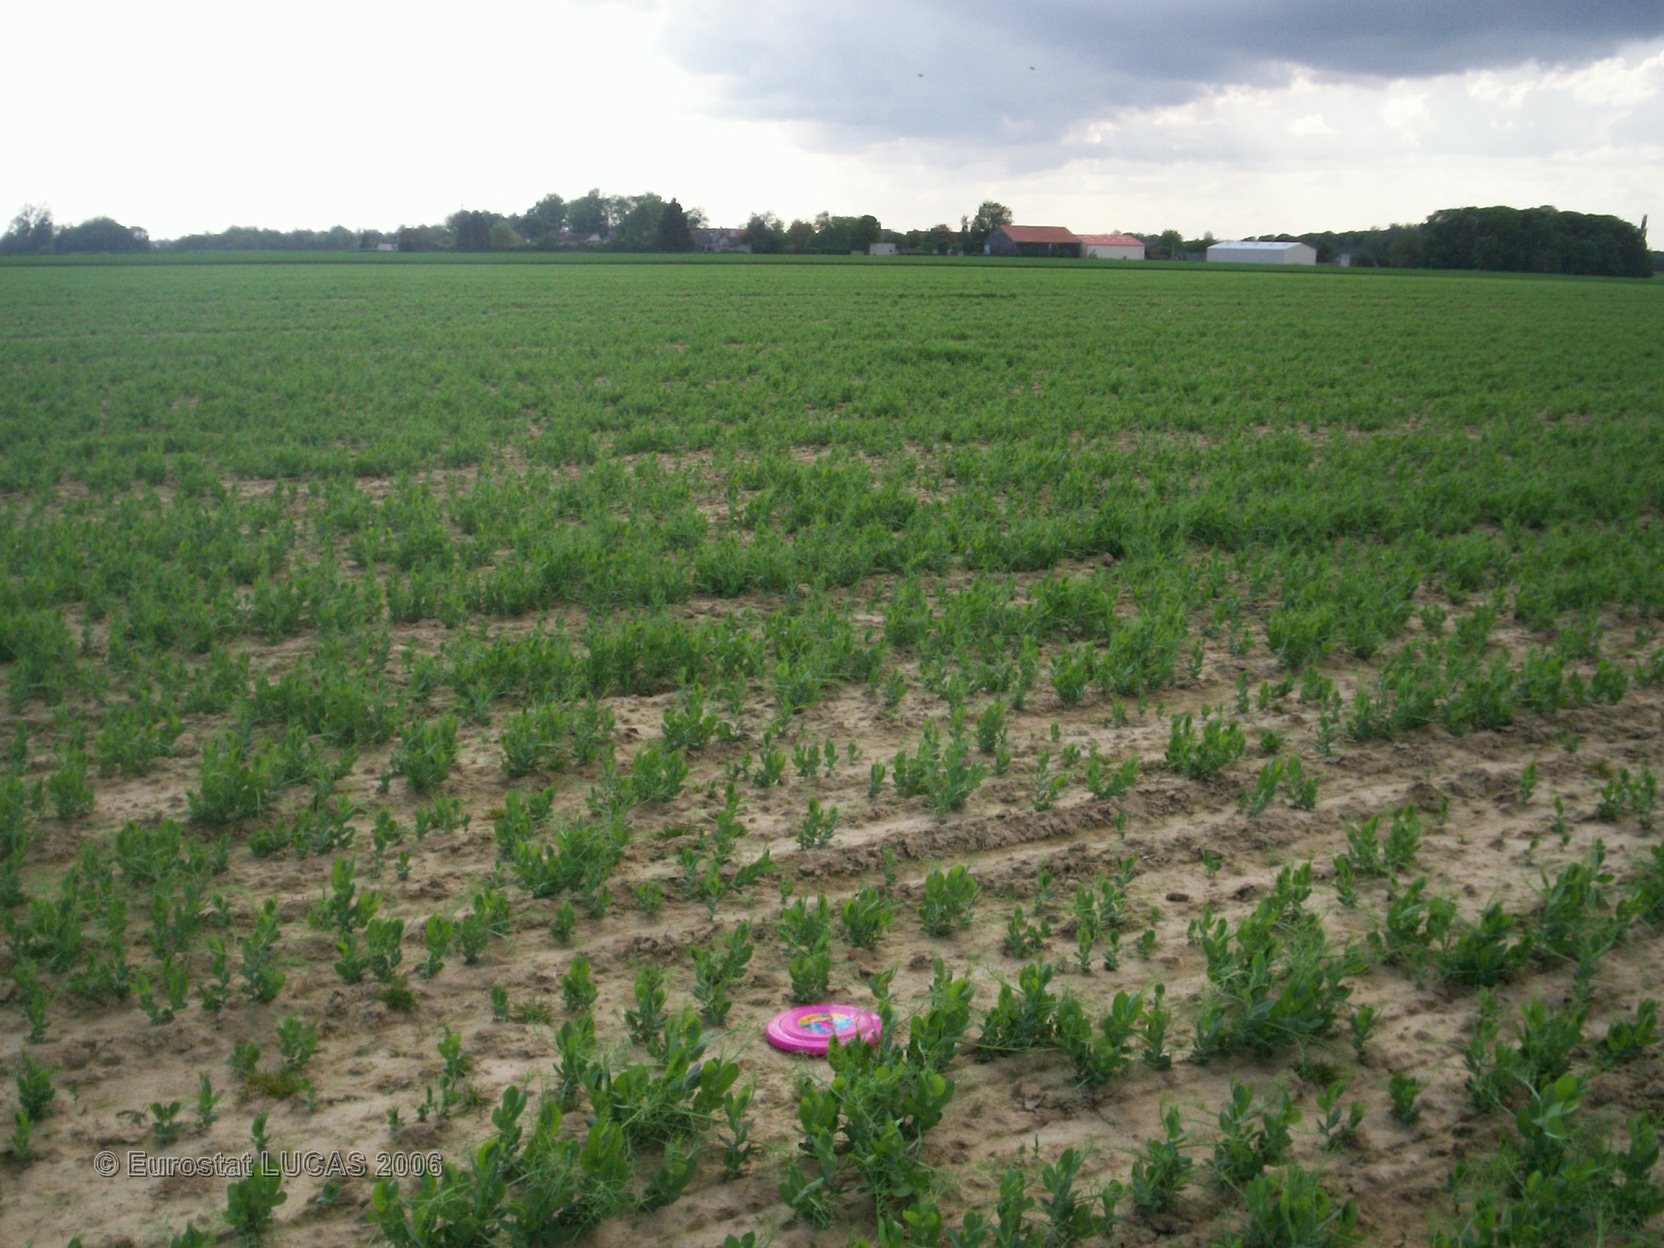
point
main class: Cropland
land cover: Dry pulses
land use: Agriculture (excluding fallow land and kitchen gardens)
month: May
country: FR
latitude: 48.7464
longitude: 2.7962
